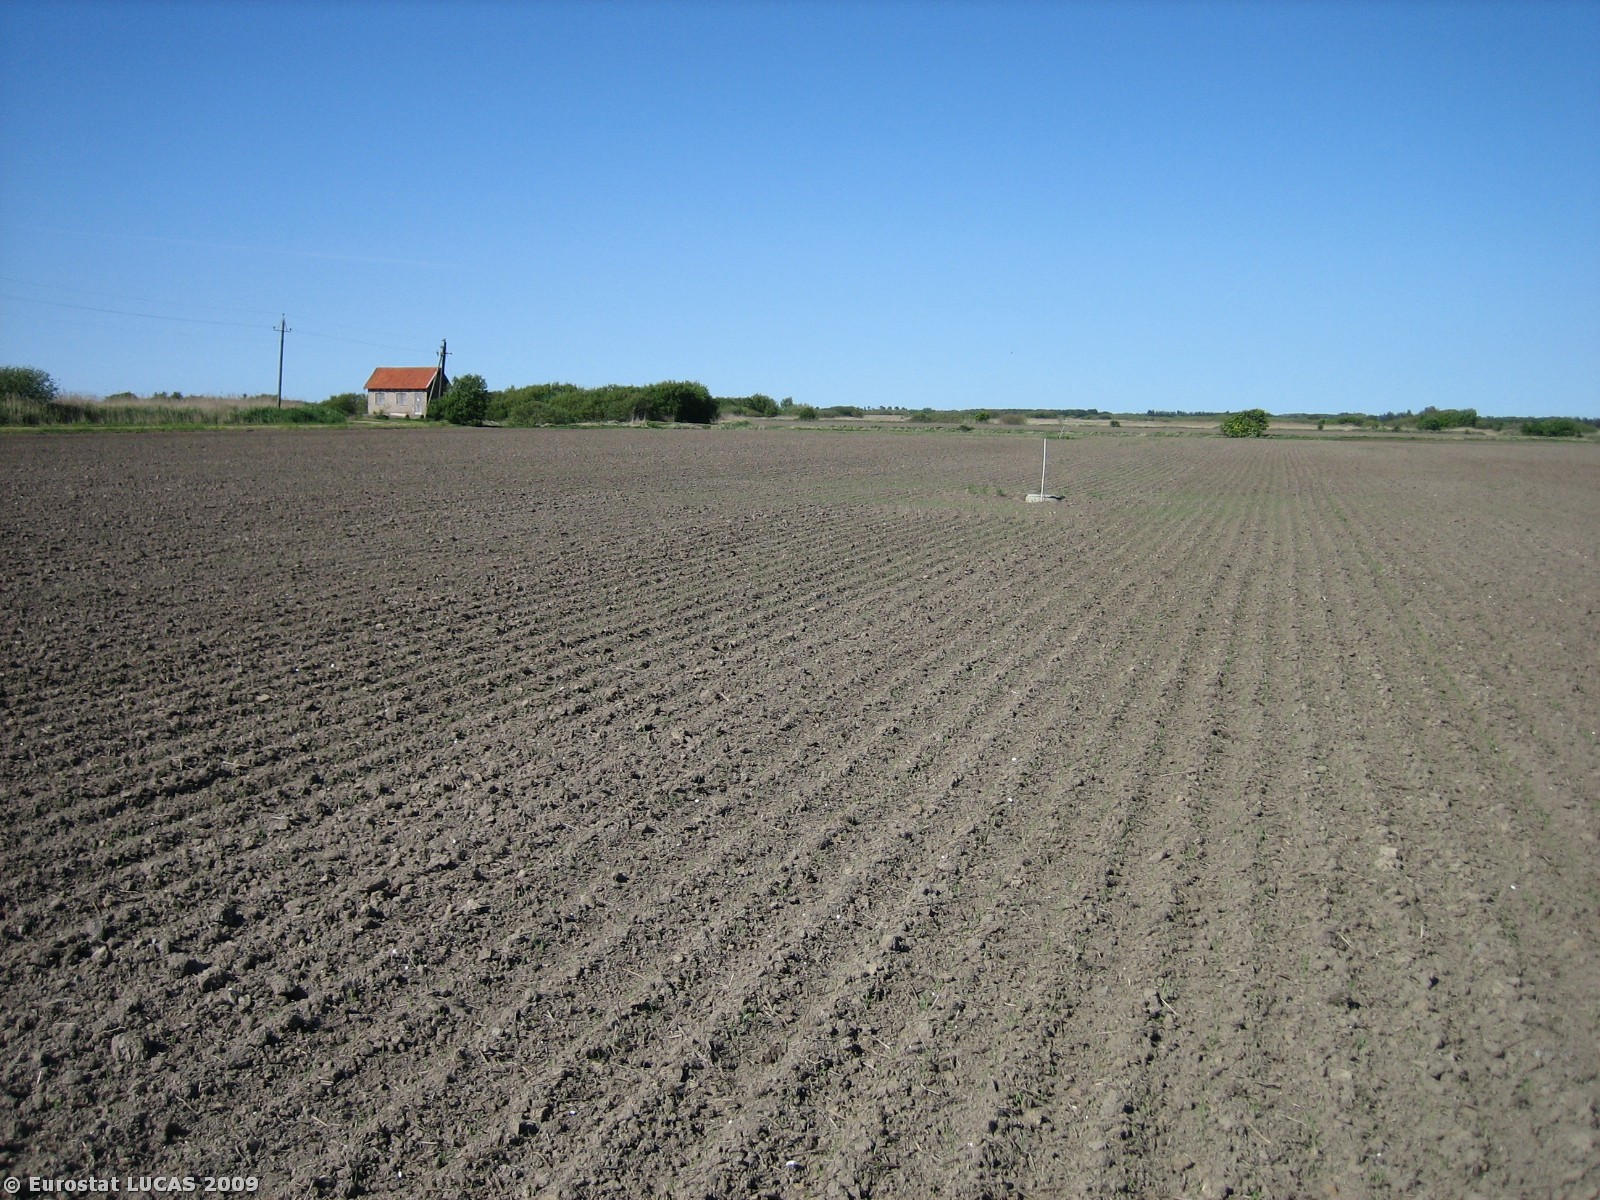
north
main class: Cropland
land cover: Barley
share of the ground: < 10 %
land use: Agriculture (excluding fallow land and kitchen gardens)
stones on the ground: < 10 %
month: May
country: DK
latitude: 56.2472
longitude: 8.2107
